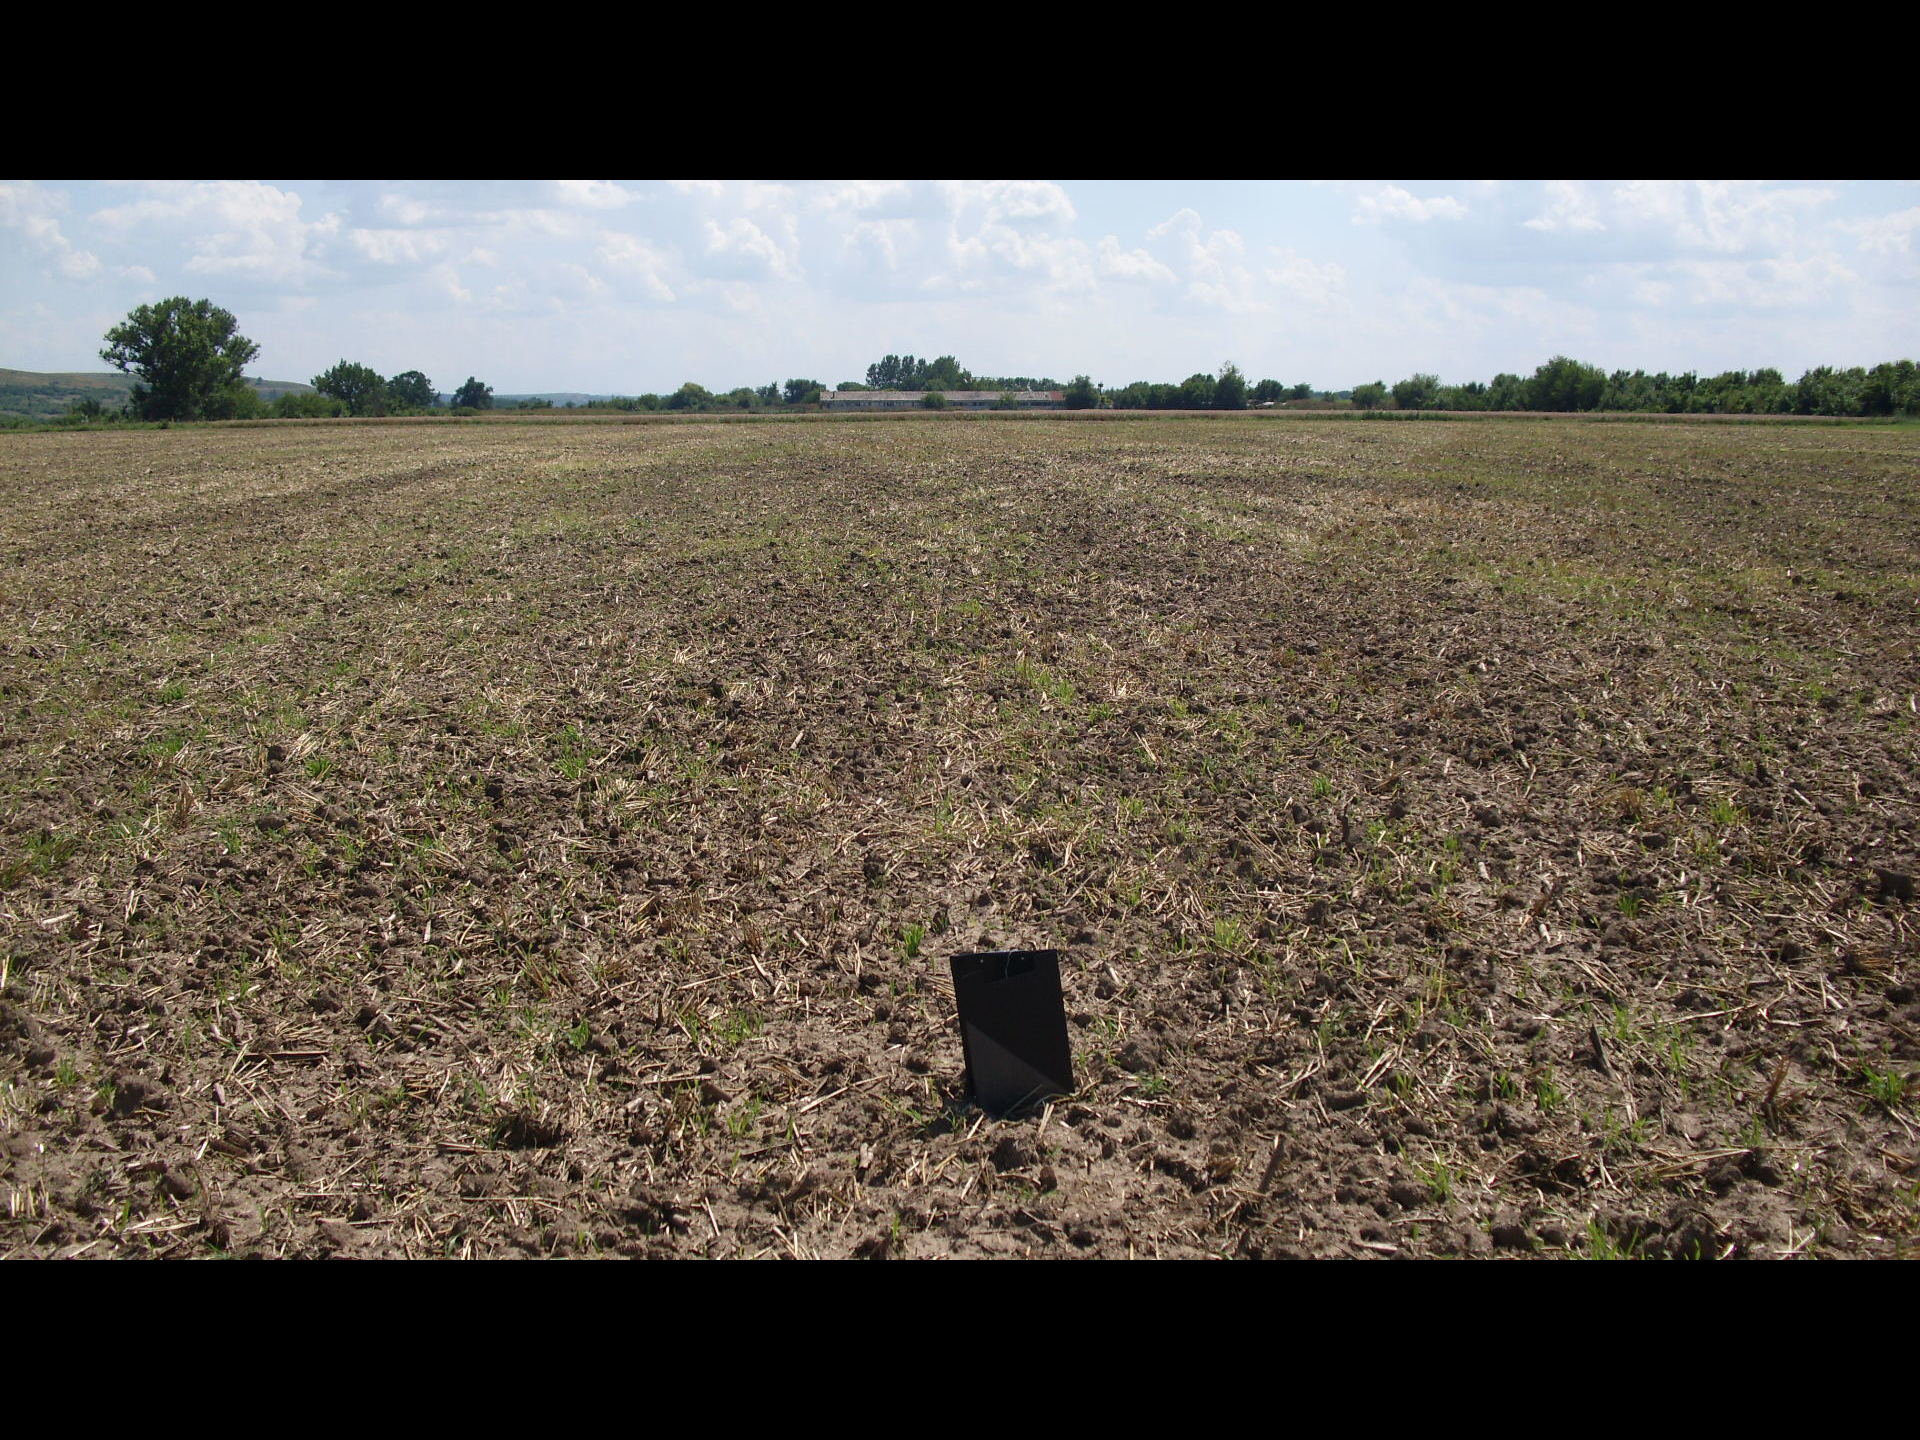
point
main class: Cropland
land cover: Barley
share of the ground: > 75 %
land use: Agriculture (excluding fallow land and kitchen gardens)
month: July
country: BG
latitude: 43.7241
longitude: 23.4651
